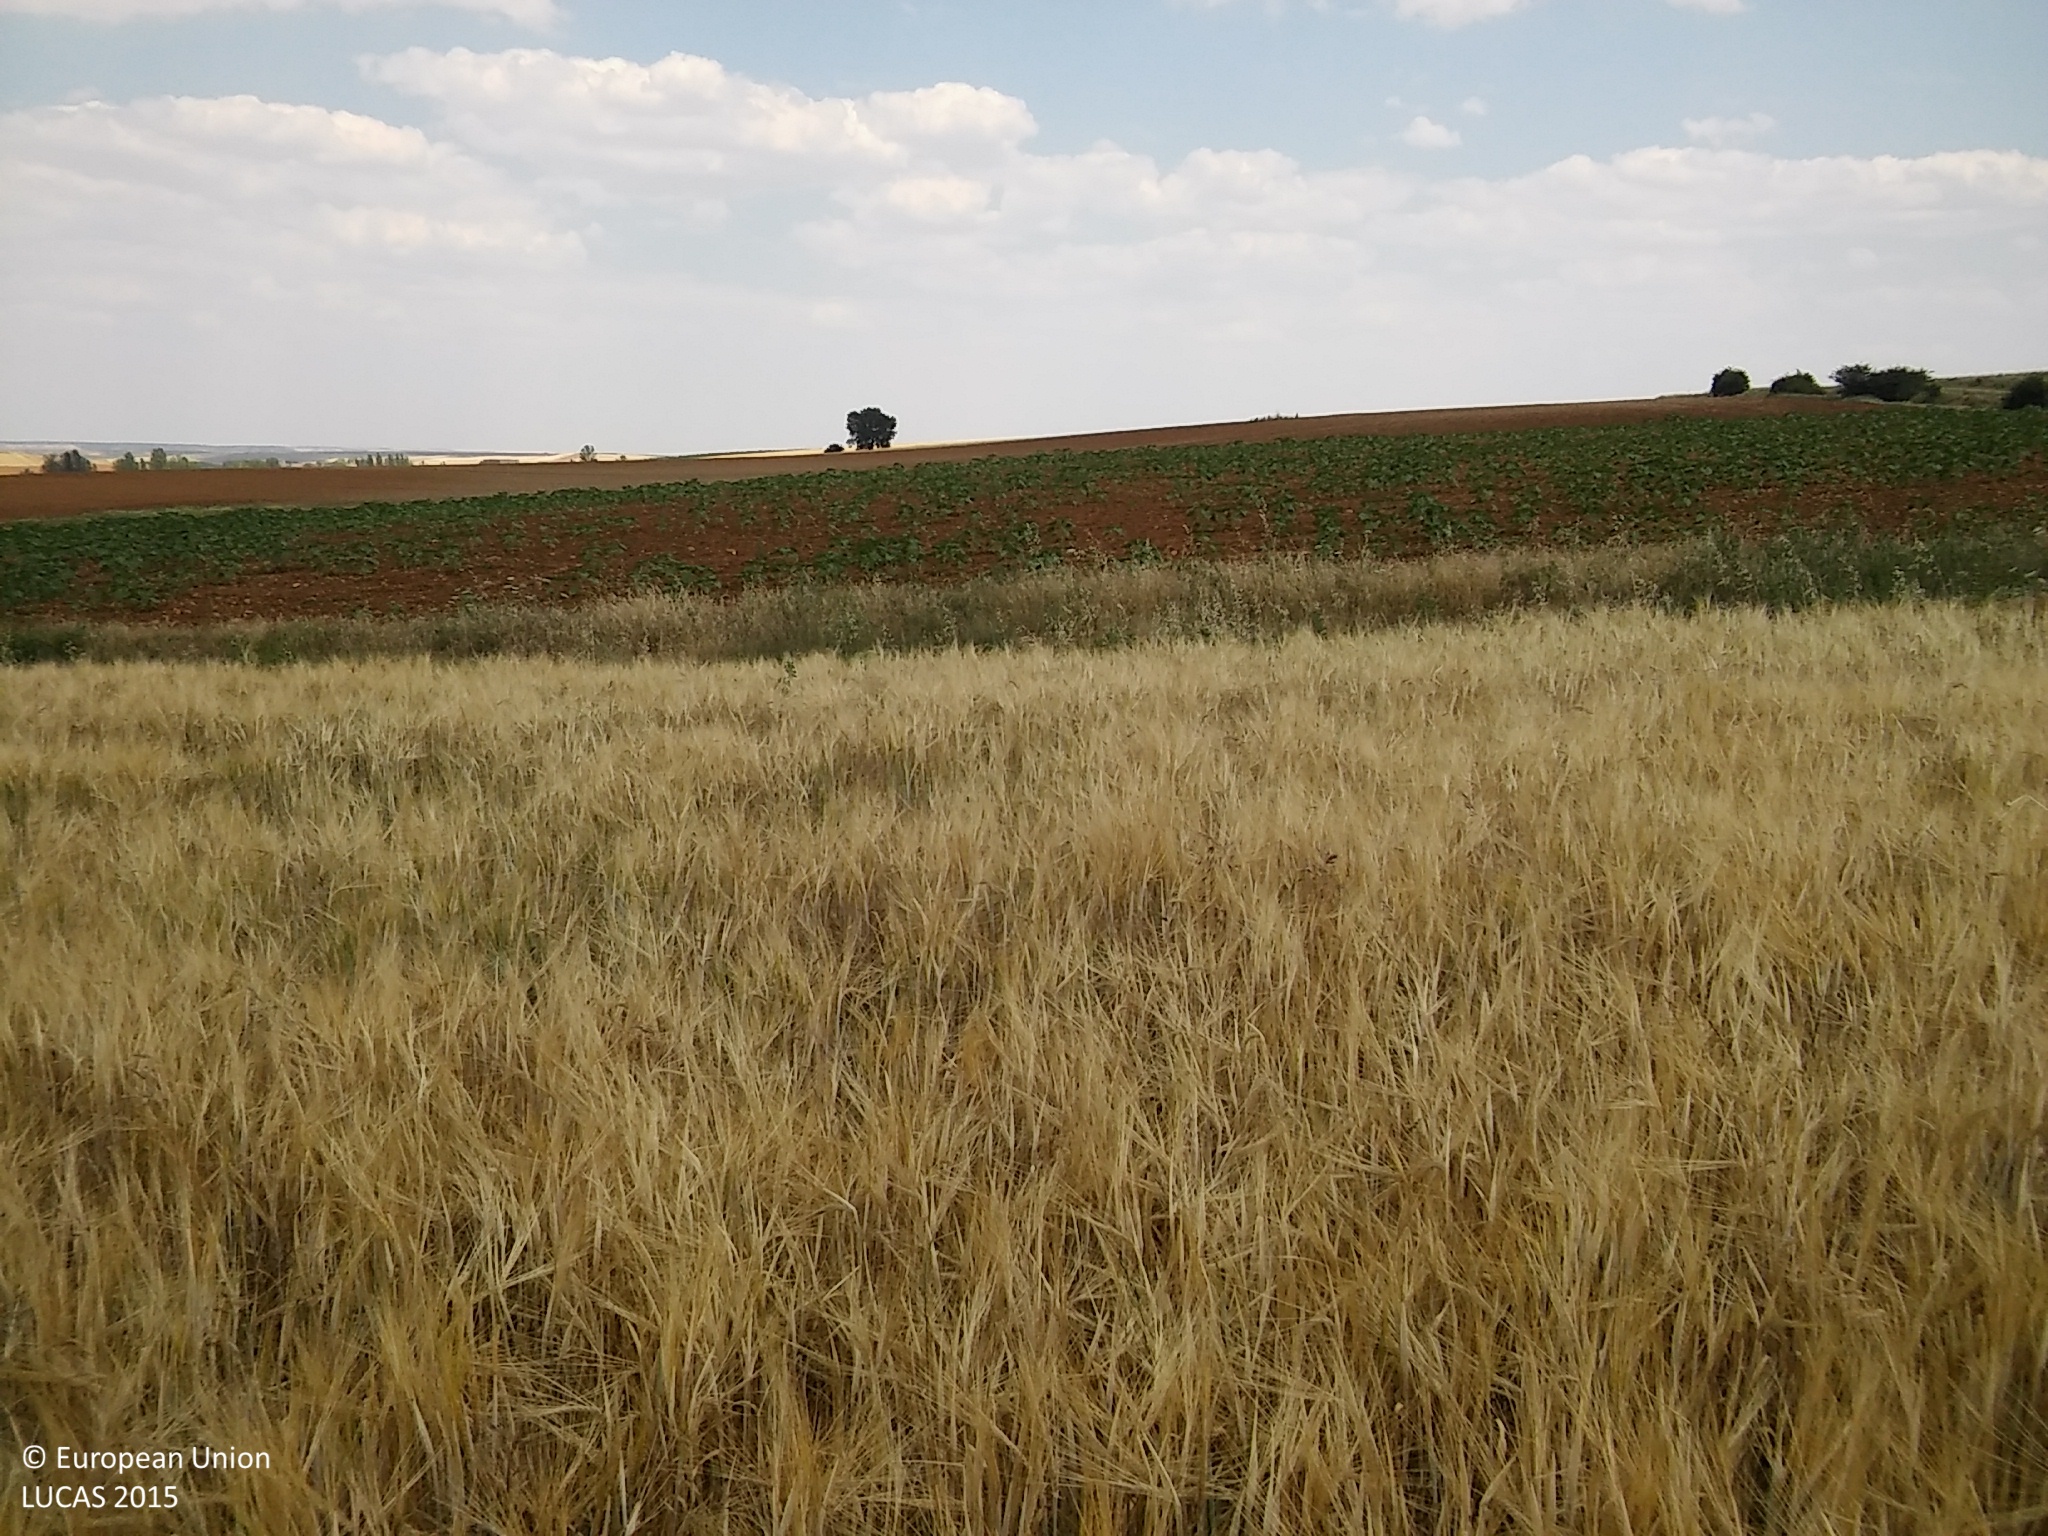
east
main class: Cropland
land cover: Barley
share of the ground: > 75 %
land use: Agriculture (excluding fallow land and kitchen gardens)
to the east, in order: Barley; Grass margins; Ditches and canals; Grass margins; Sunflower; Other bare soil
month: June
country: ES
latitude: 41.3913
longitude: -3.5498
